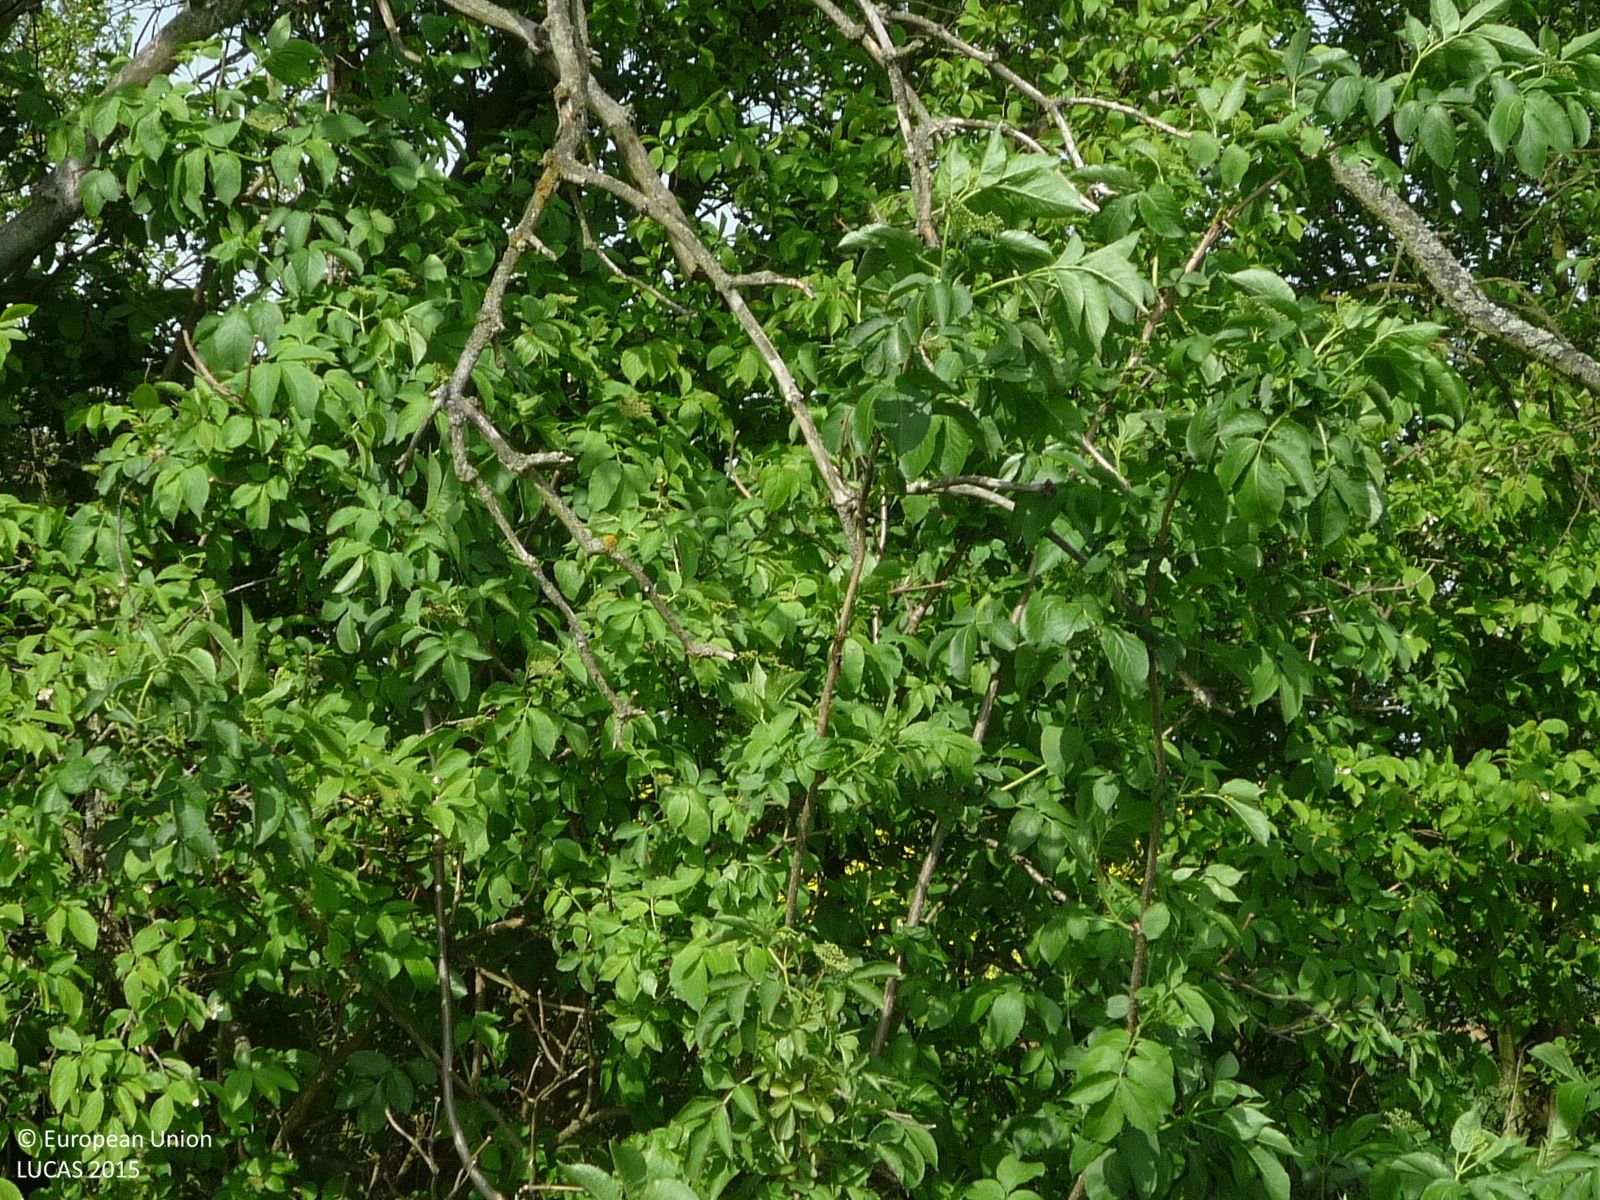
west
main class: Cropland
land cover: Common wheat
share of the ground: > 75 %
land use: Agriculture (excluding fallow land and kitchen gardens)
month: May
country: CZ
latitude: 50.0510
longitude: 14.7086
